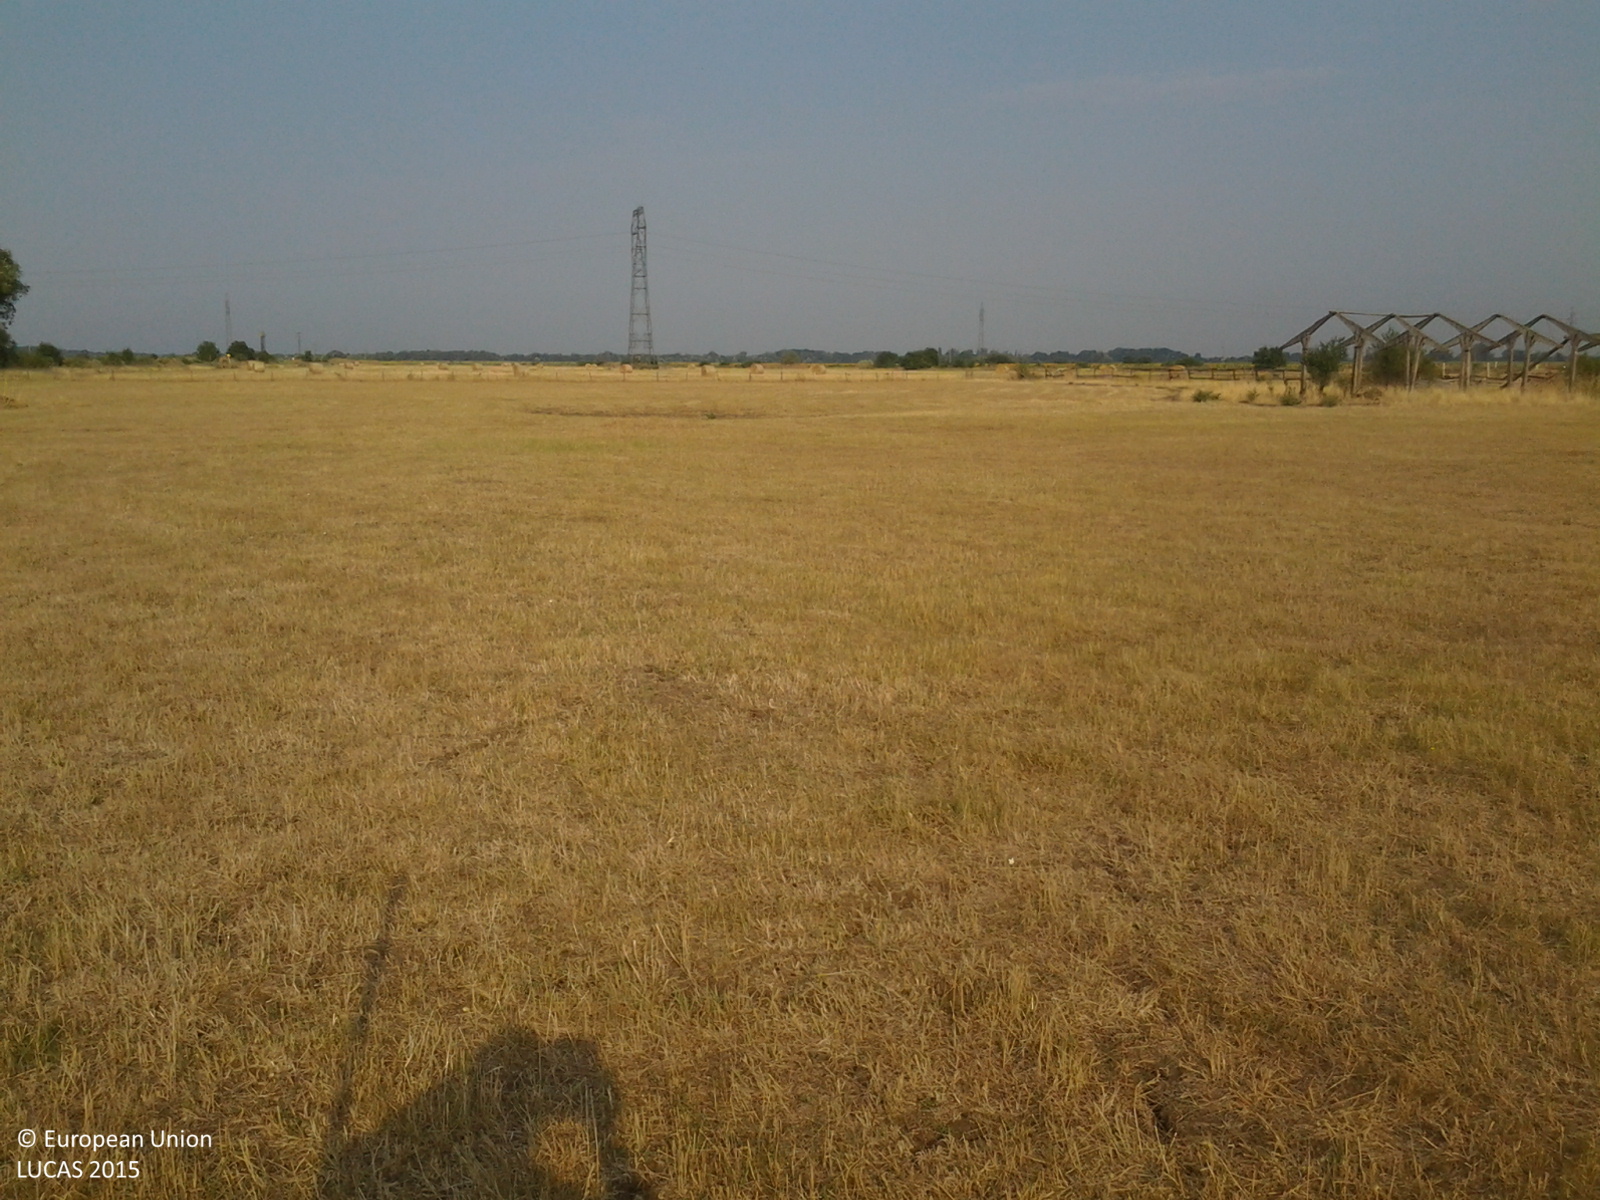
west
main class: Grassland
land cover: Grassland without tree/shrub cover
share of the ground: > 75 %
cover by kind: herbaceous plants 100 %
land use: Agriculture (excluding fallow land and kitchen gardens)
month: July
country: HU
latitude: 46.9785
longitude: 20.6655
